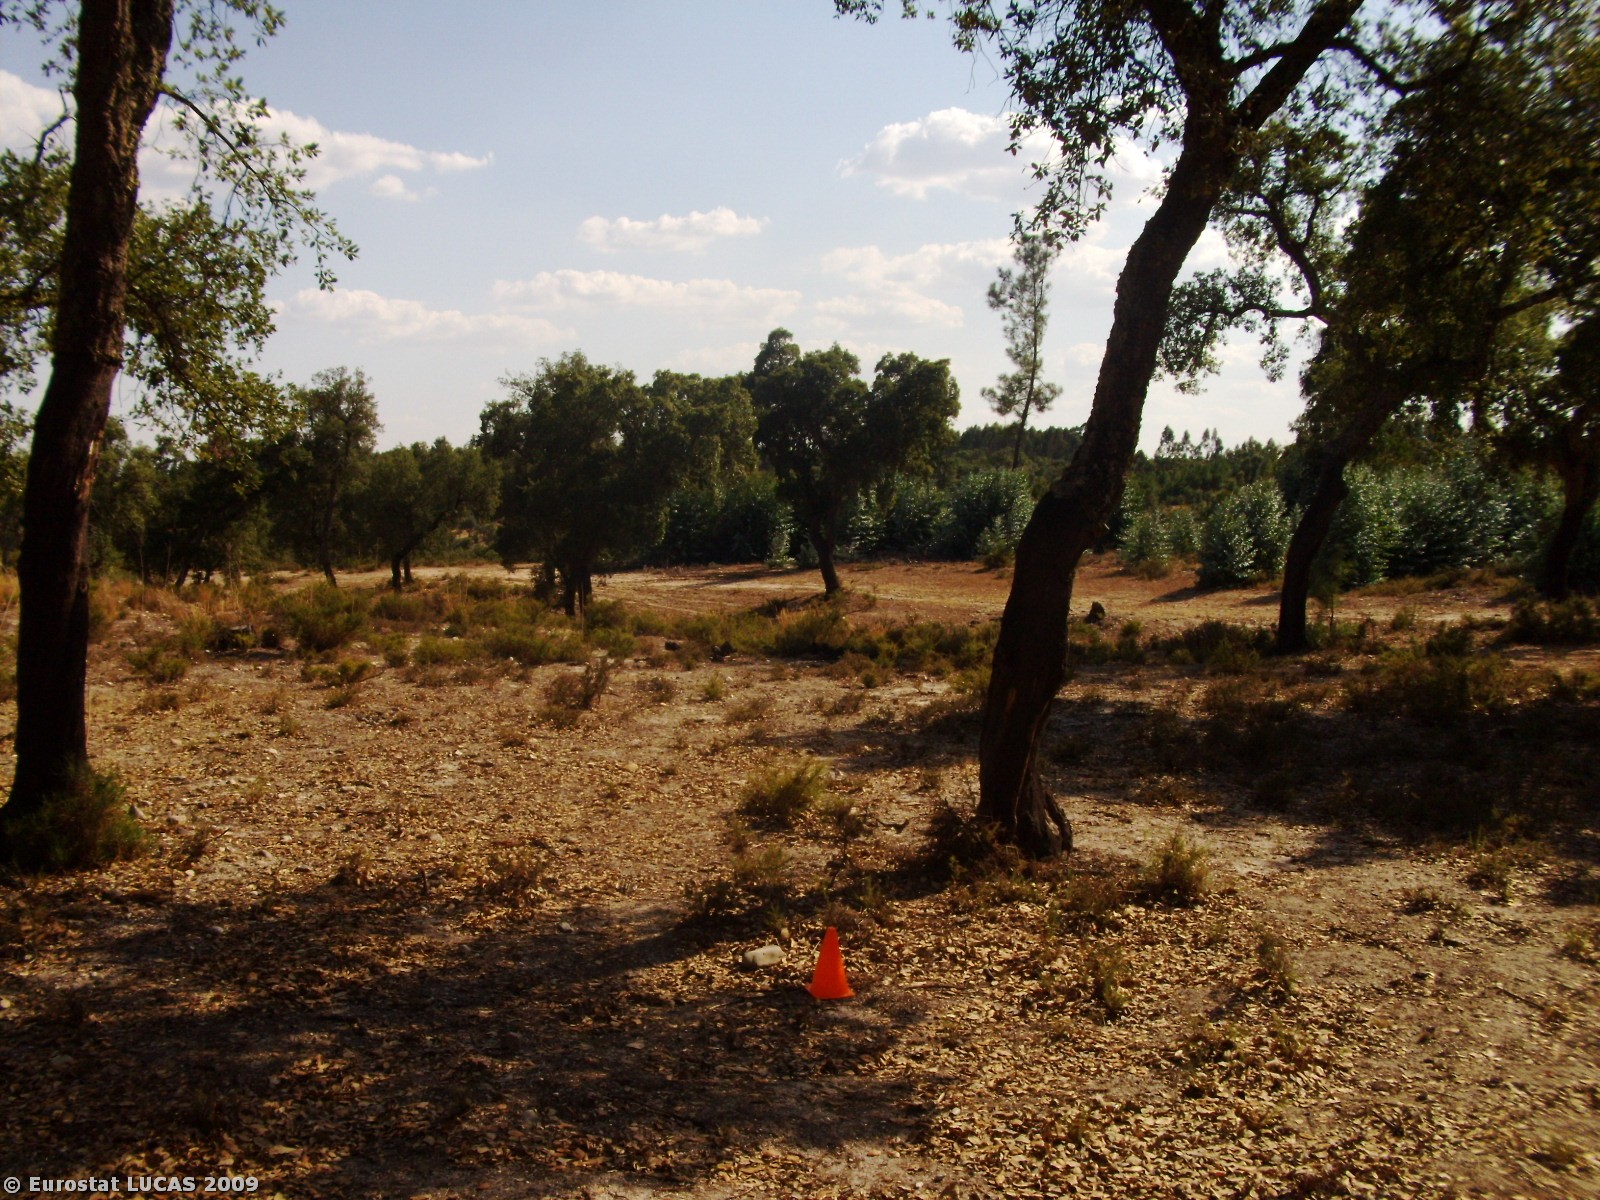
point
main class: Woodland
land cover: Broadleaved woodland
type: broadleaved evergreen forest
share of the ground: > 75 %
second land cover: Spontaneously vegetated surfaces
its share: 10 - 25 %
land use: Forestry
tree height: > 5 m
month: August
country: PT
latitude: 39.3218
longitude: -8.0240
